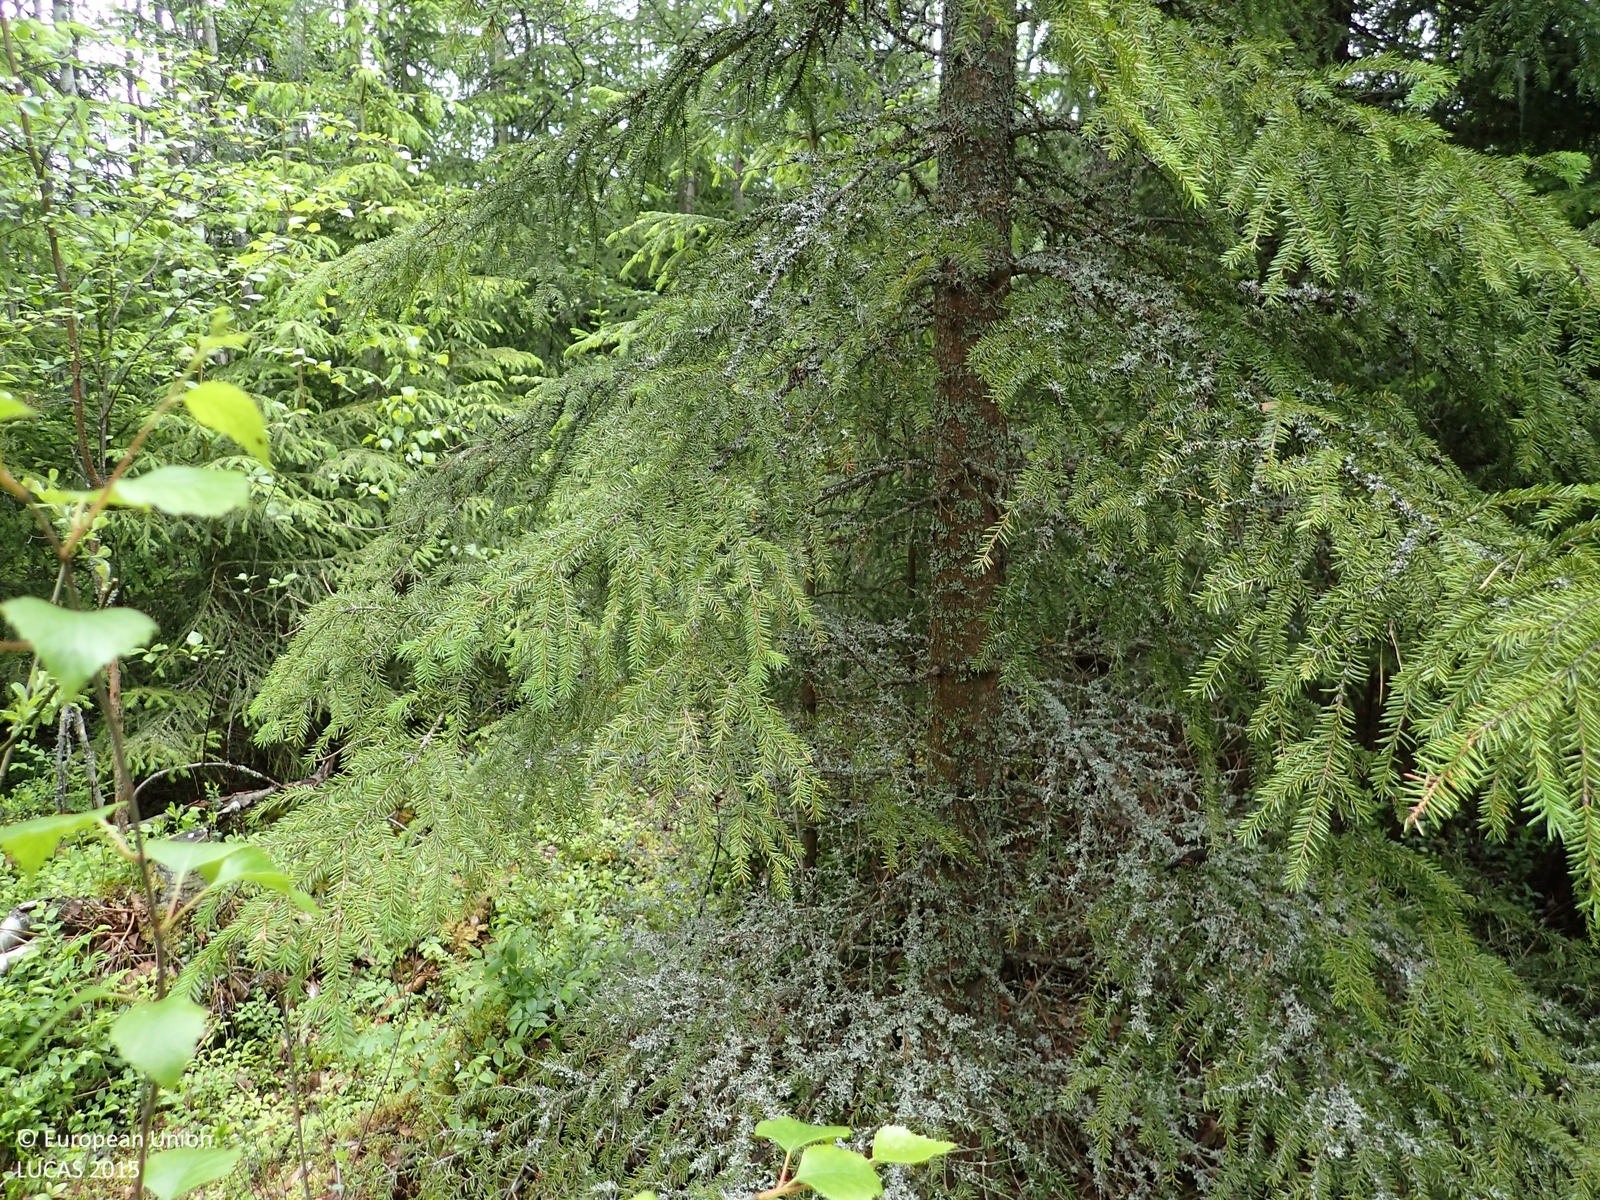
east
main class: Woodland
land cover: Other mixed woodland
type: boreal forest
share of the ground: > 75 %
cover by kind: broadleaved forest trees 45 %, coniferous forest trees 35 %, shrubs 20 %
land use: Forestry
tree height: > 5 m
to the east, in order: Other mixed woodland; Broadleaved woodland; Electric lines; Broadleaved woodland; Ditches and canals; Other mixed woodland; Broadleaved woodland; Spruce dominated mixed woodland; Ditches and canals; Tracks; Spruce dominated mixed woodland; Tracks; Spruce dominated coniferous woodland; Tracks; Spruce dominated coniferous woodland
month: June
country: FI
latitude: 62.3439
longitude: 21.3792
